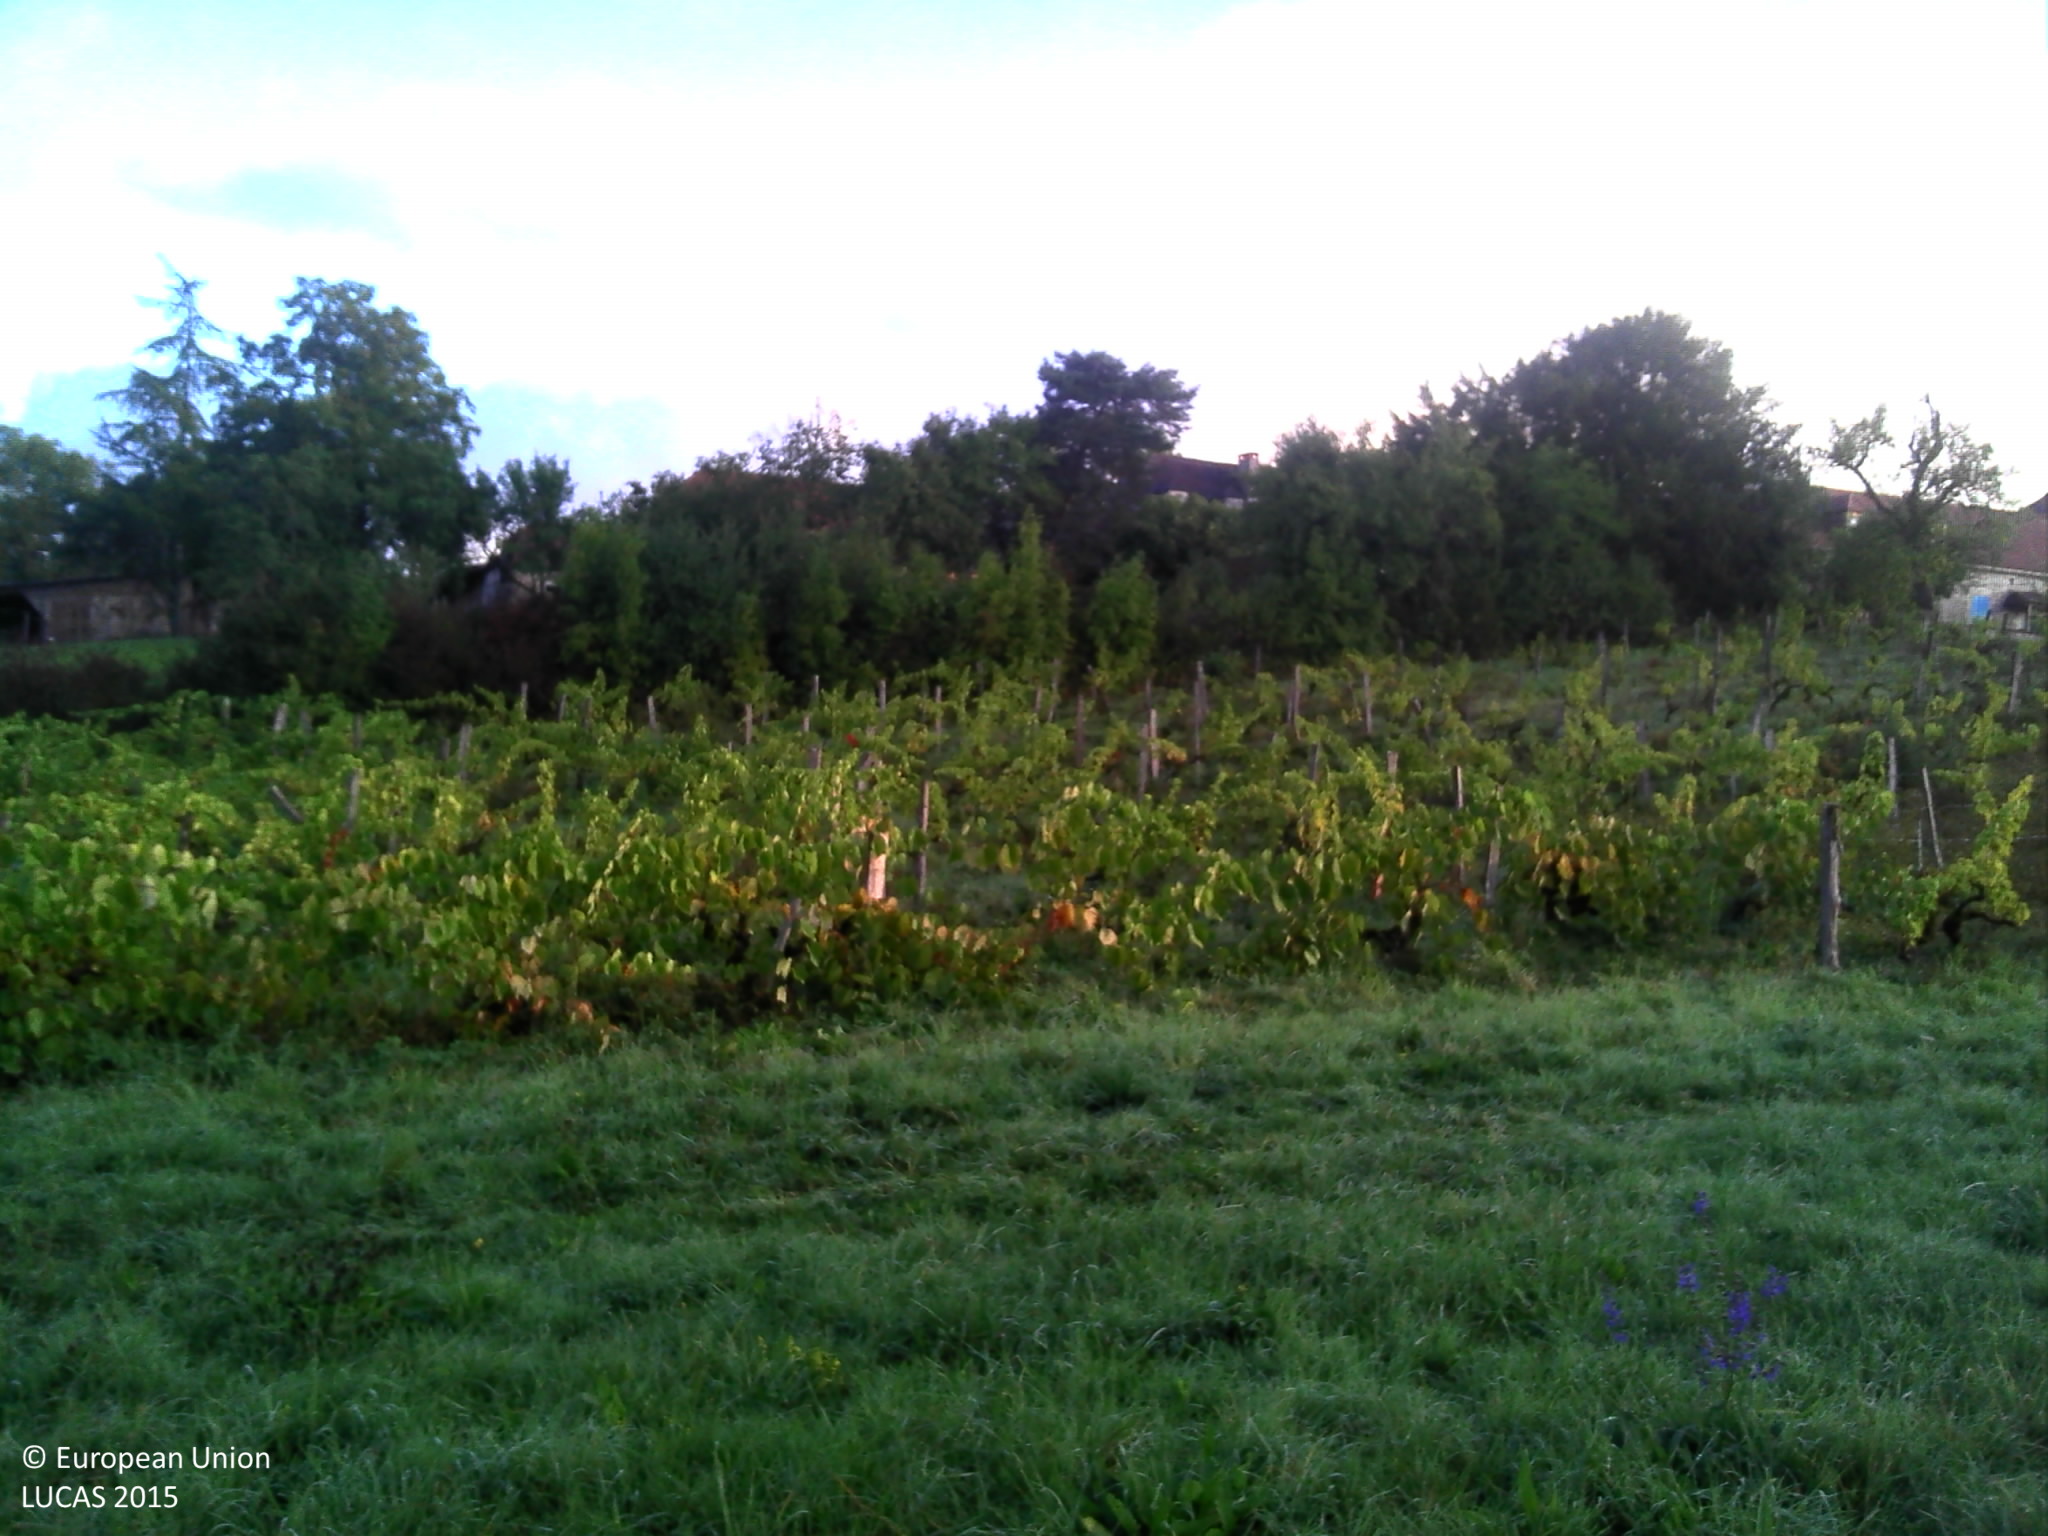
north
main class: Grassland
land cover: Grassland without tree/shrub cover
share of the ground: > 75 %
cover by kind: herbaceous plants 100 %
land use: Agriculture (excluding fallow land and kitchen gardens)
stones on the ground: < 10 %
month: December
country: FR
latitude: 45.0009
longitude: 1.5344
